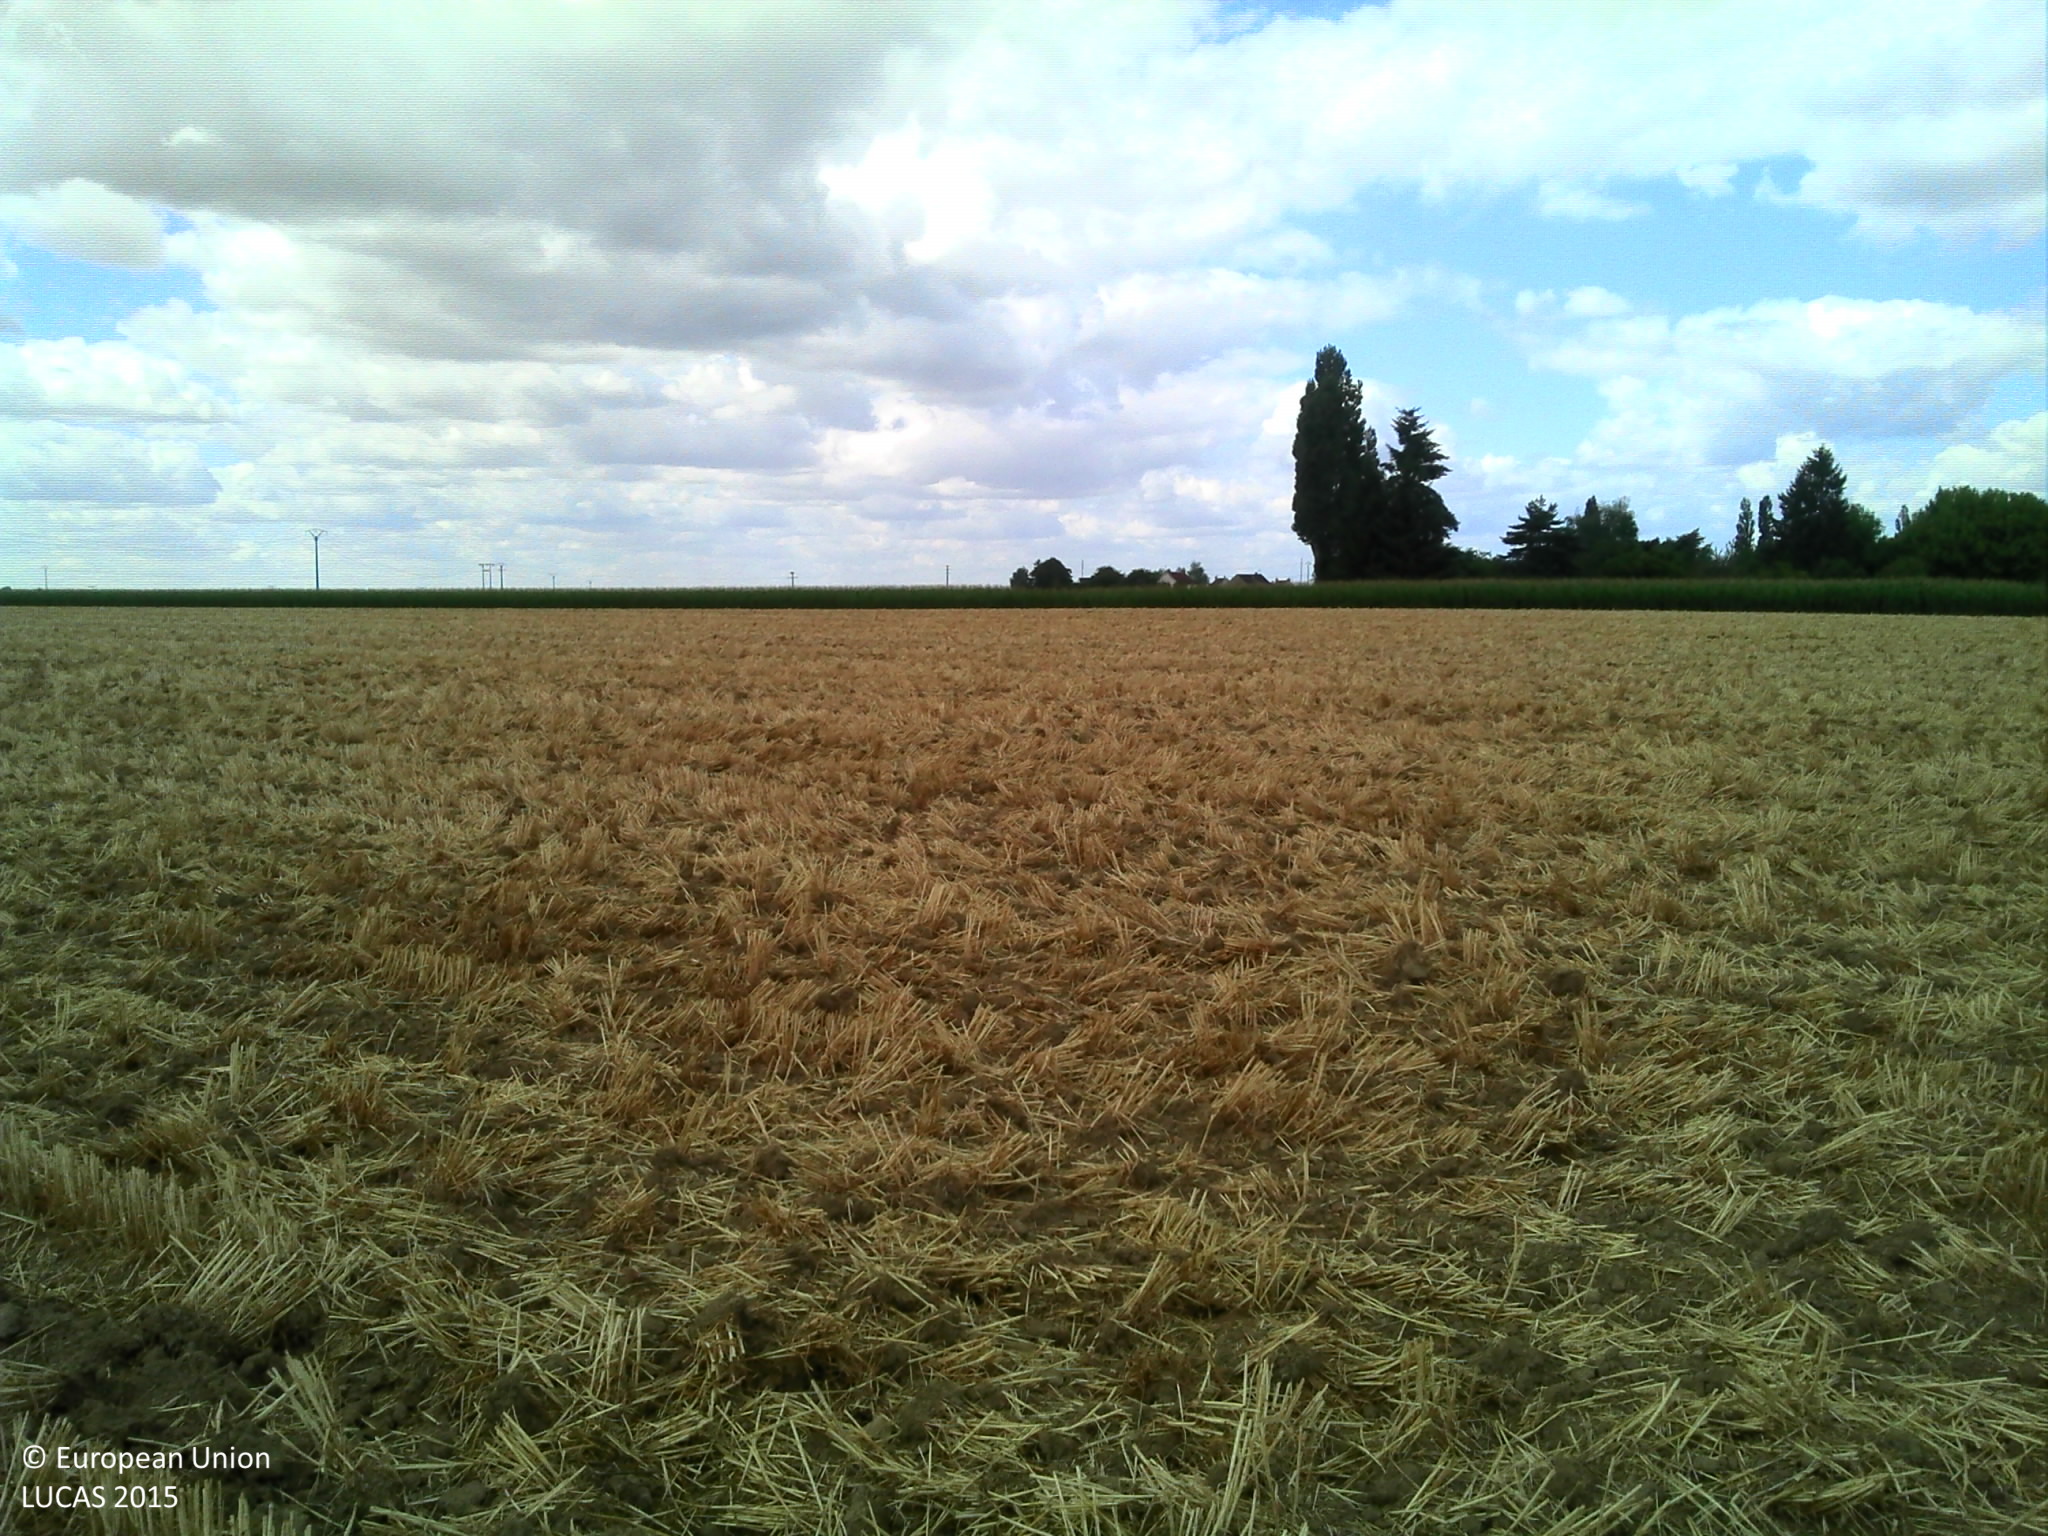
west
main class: Cropland
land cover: Common wheat
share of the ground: > 75 %
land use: Agriculture (excluding fallow land and kitchen gardens)
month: July
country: FR
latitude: 48.6315
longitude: 2.9764
